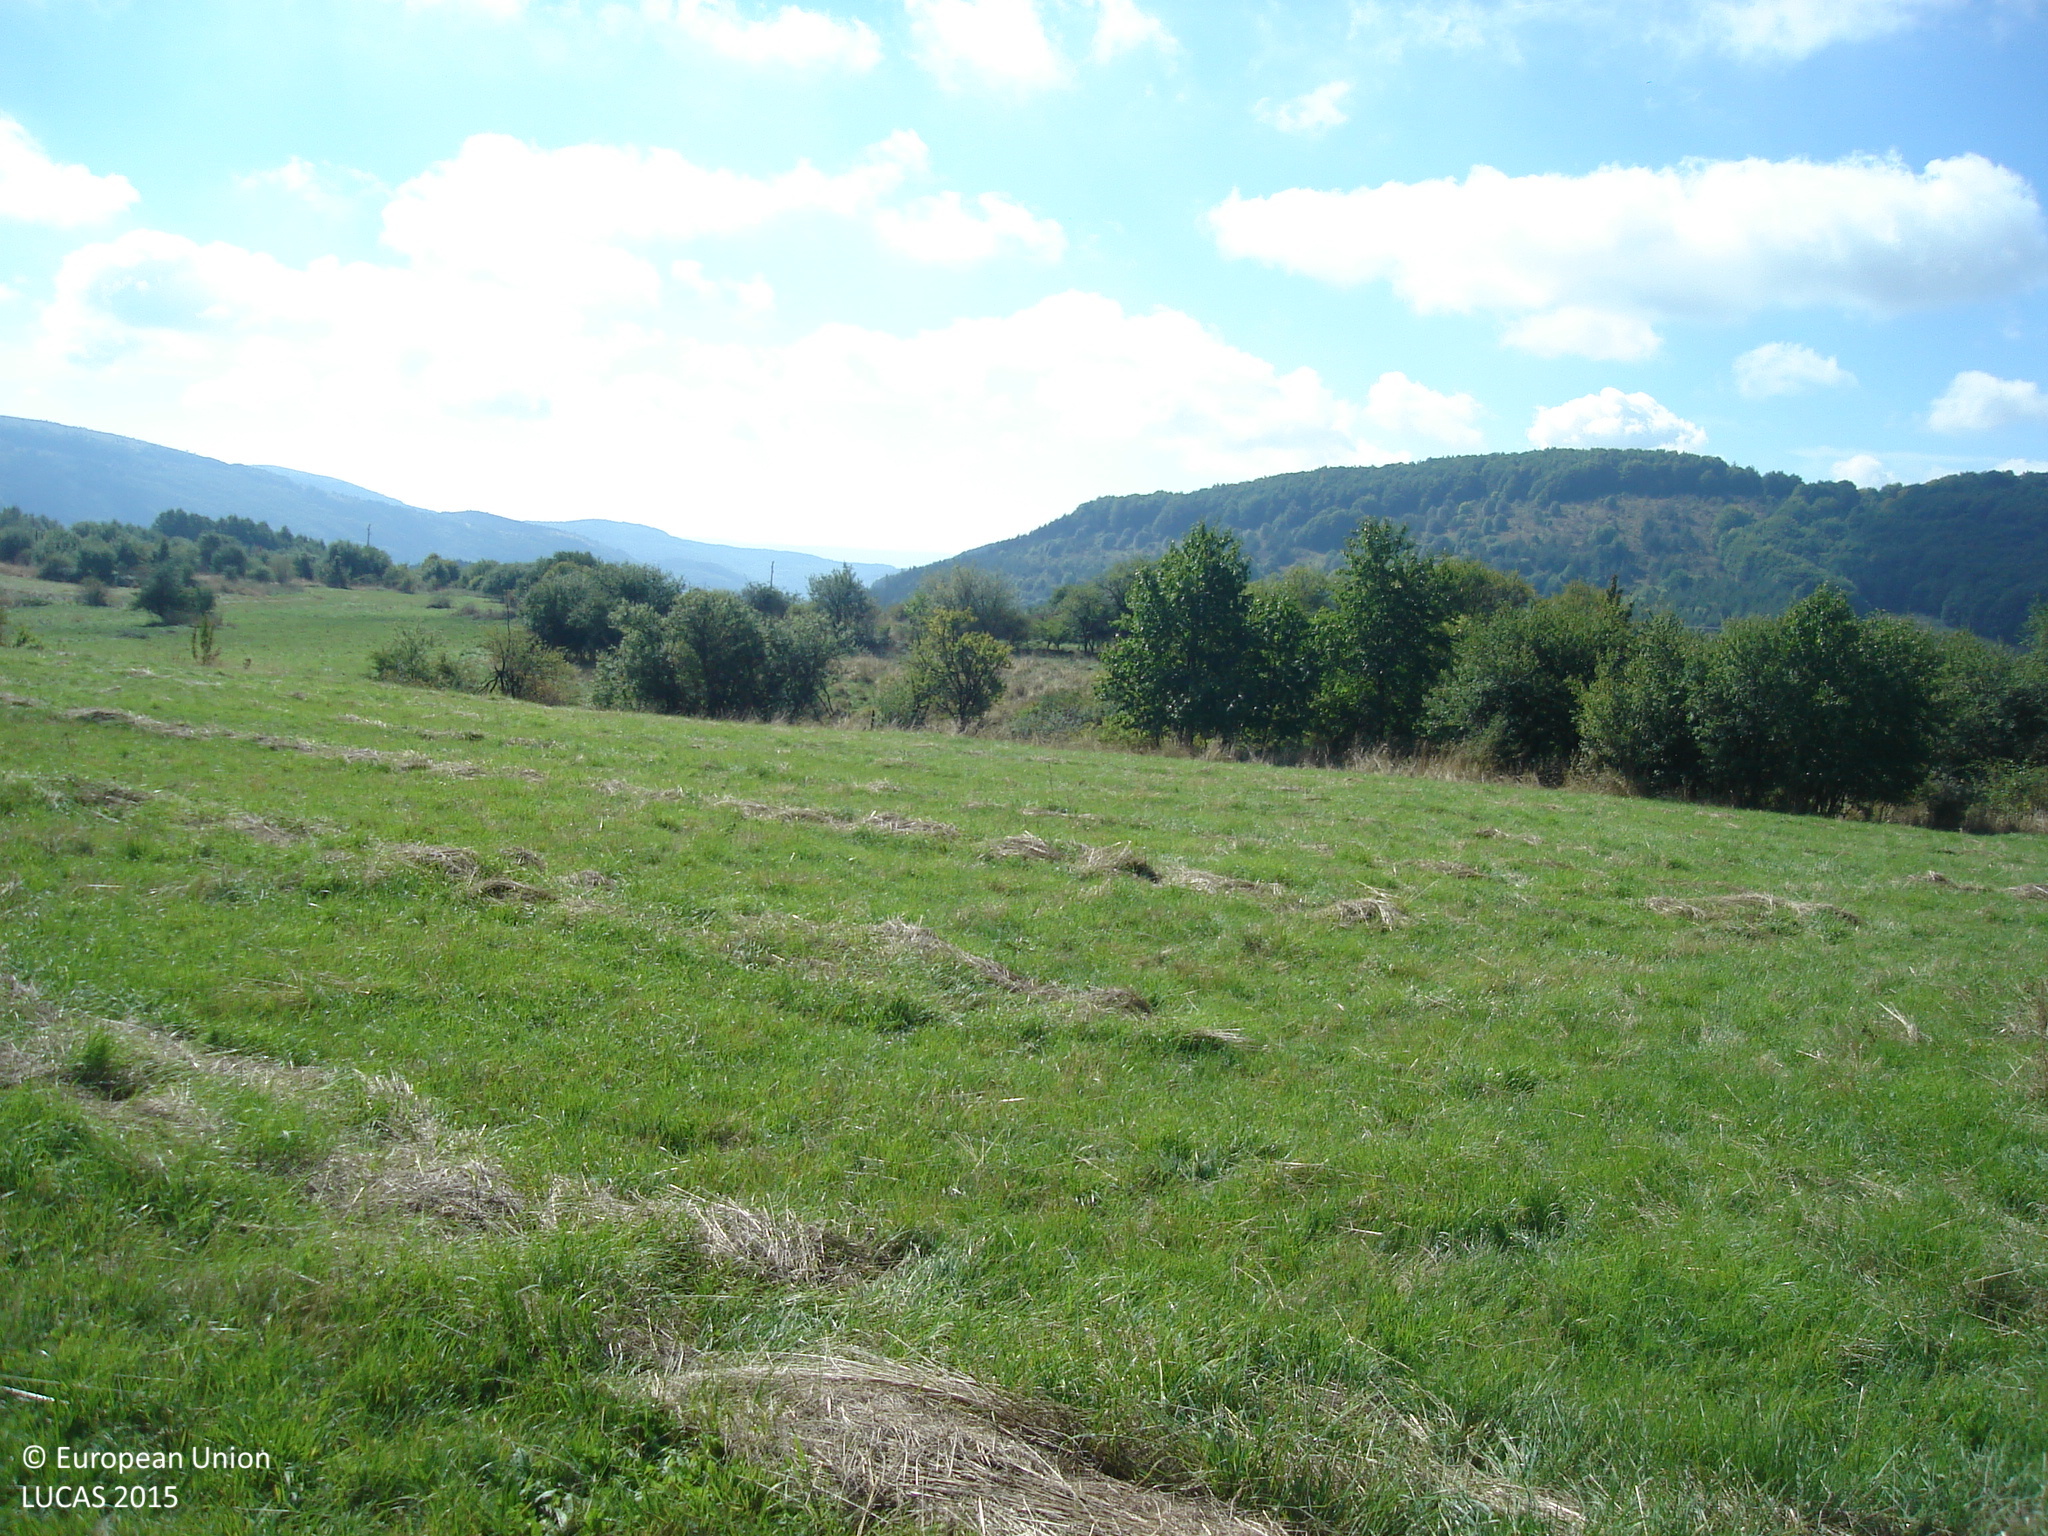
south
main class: Grassland
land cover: Grassland without tree/shrub cover
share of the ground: > 75 %
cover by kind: herbaceous plants 100 %
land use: Agriculture (excluding fallow land and kitchen gardens)
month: October
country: BG
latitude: 43.0727
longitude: 23.1393
